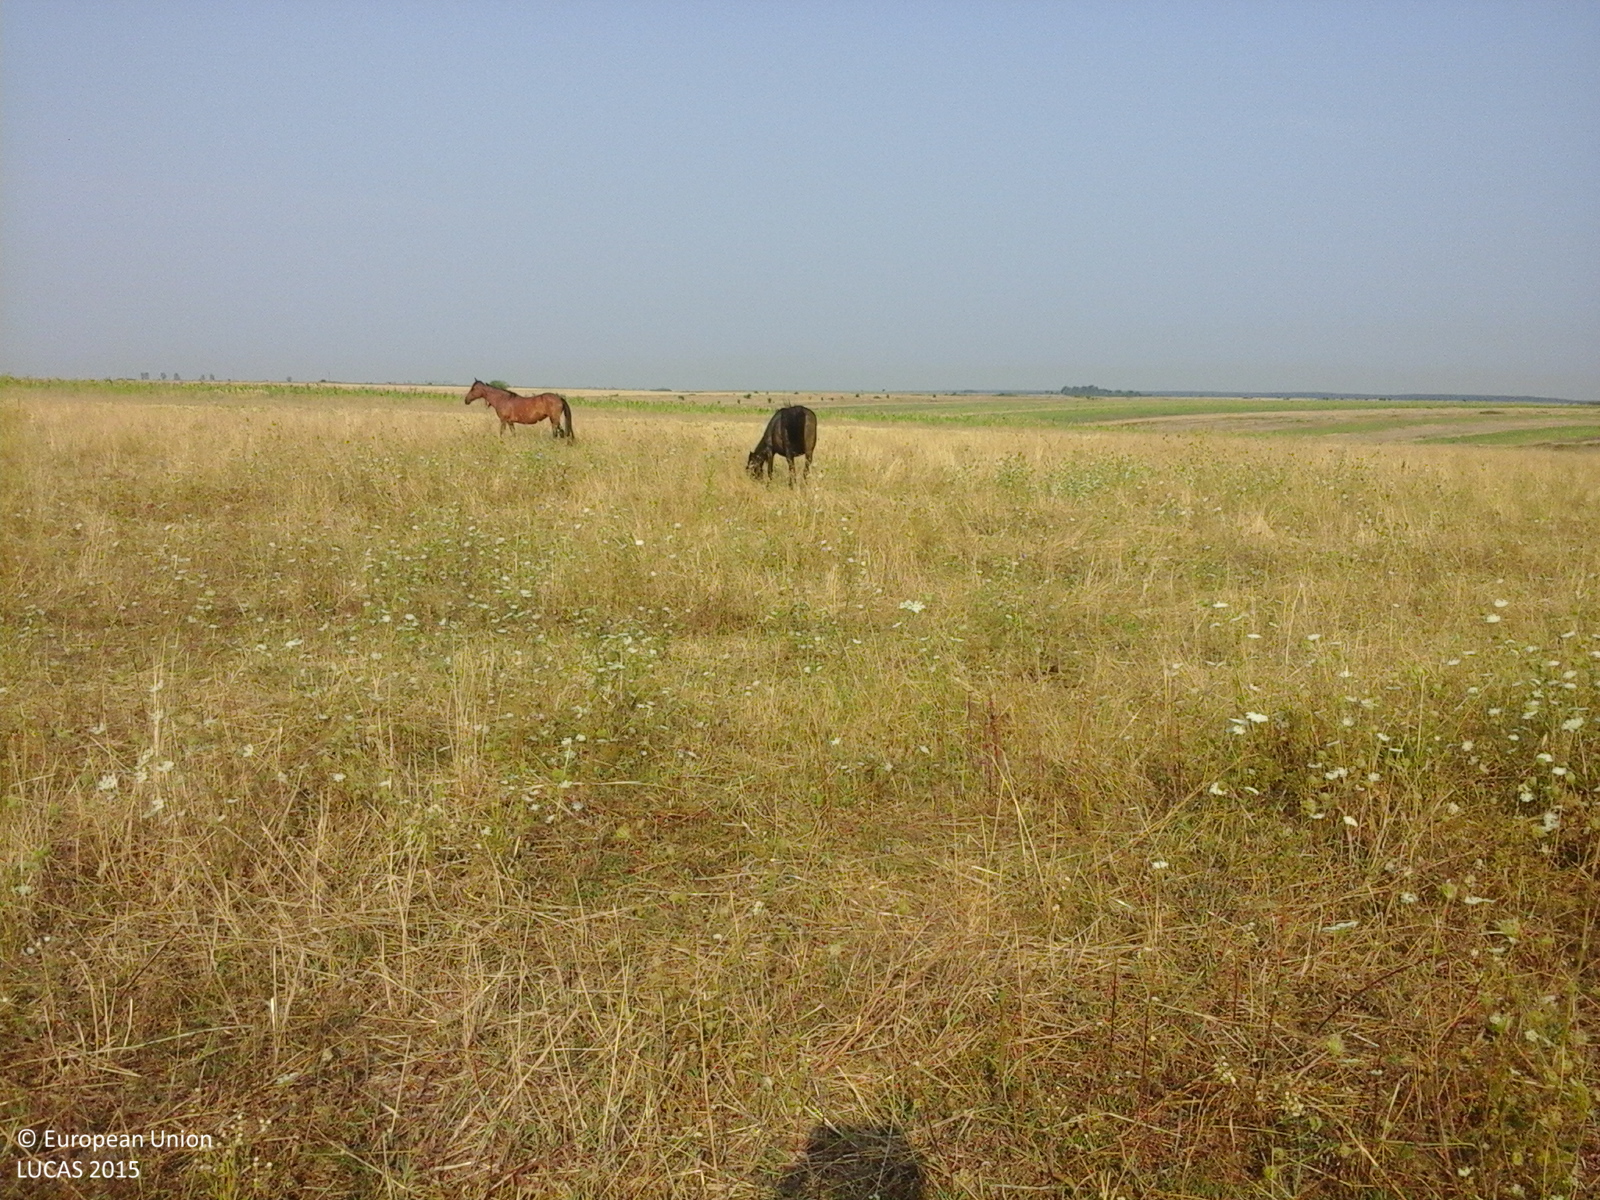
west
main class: Grassland
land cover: Grassland without tree/shrub cover
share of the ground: > 75 %
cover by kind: herbaceous plants 100 %
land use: Agriculture (excluding fallow land and kitchen gardens)
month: August
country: RO
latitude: 44.4775
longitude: 23.2882
